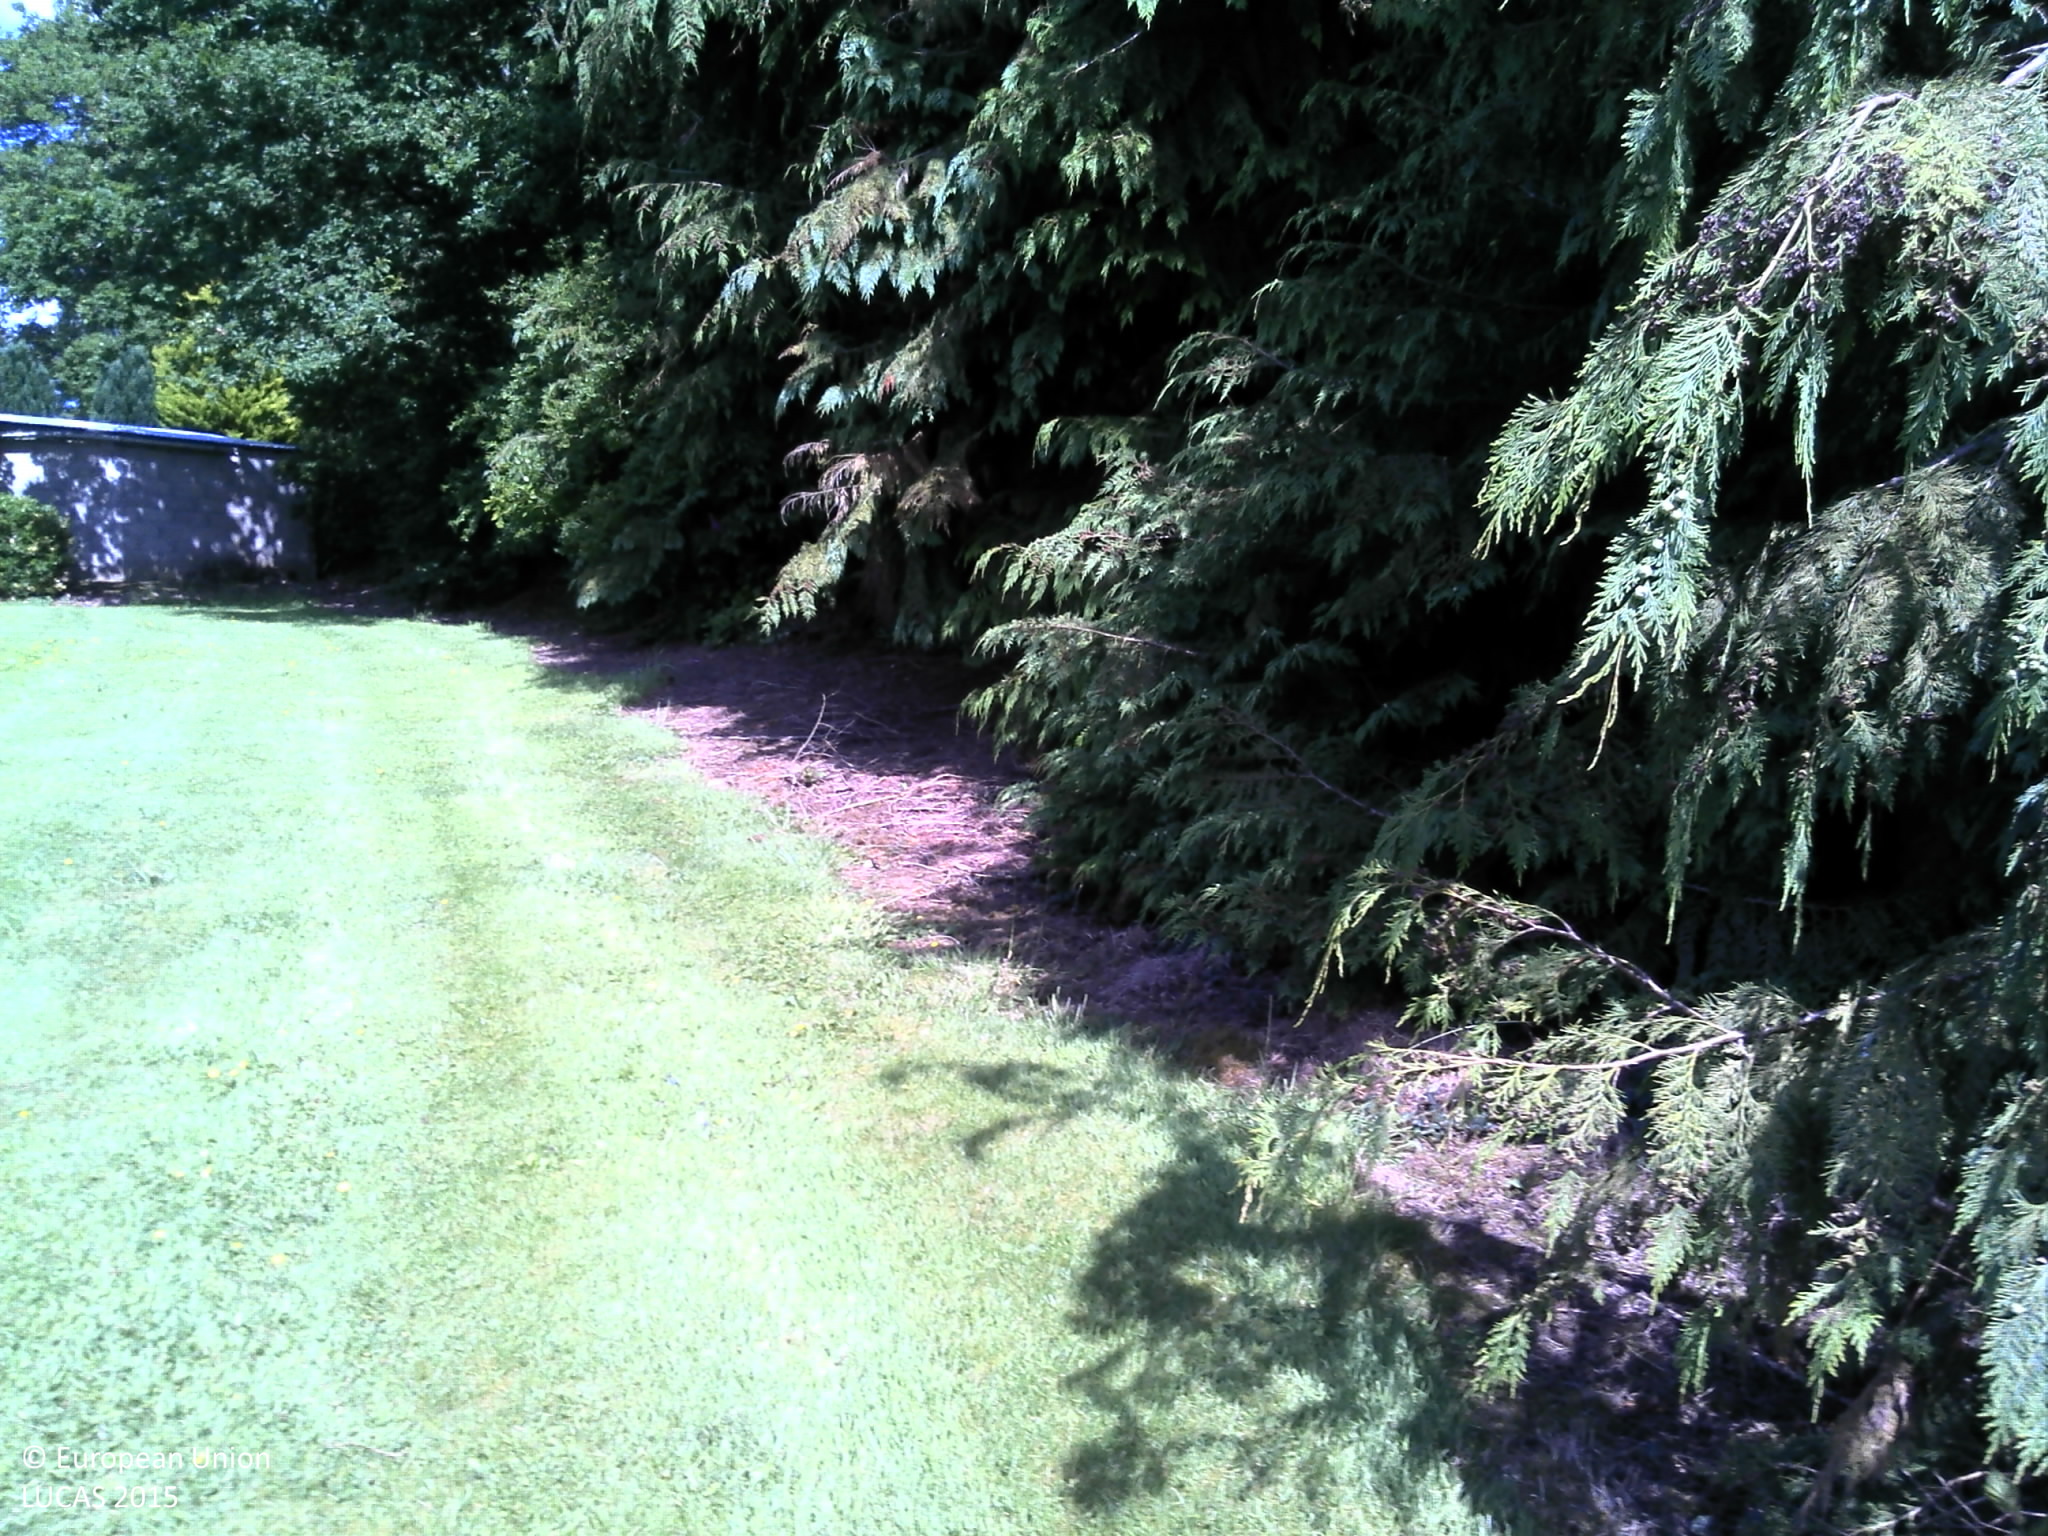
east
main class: Grassland
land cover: Grassland with sparse tree/shrub cover
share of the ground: > 75 %
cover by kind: herbaceous plants 85 %, shrubs 10 %, broadleaved forest trees 5 %
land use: Residential
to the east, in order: Other coniferous woodland; Temporary grasslands; Fences; Broadleaved woodland; Artificial constructions in urban areas; Temporary grasslands; Managed hedges; Electric lines; Ditches and canals; Grass margins; Paved roads, cycling and walking lanes; Grass margins; Managed hedges; Common wheat
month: June
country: FR
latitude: 48.4229
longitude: -3.6900
